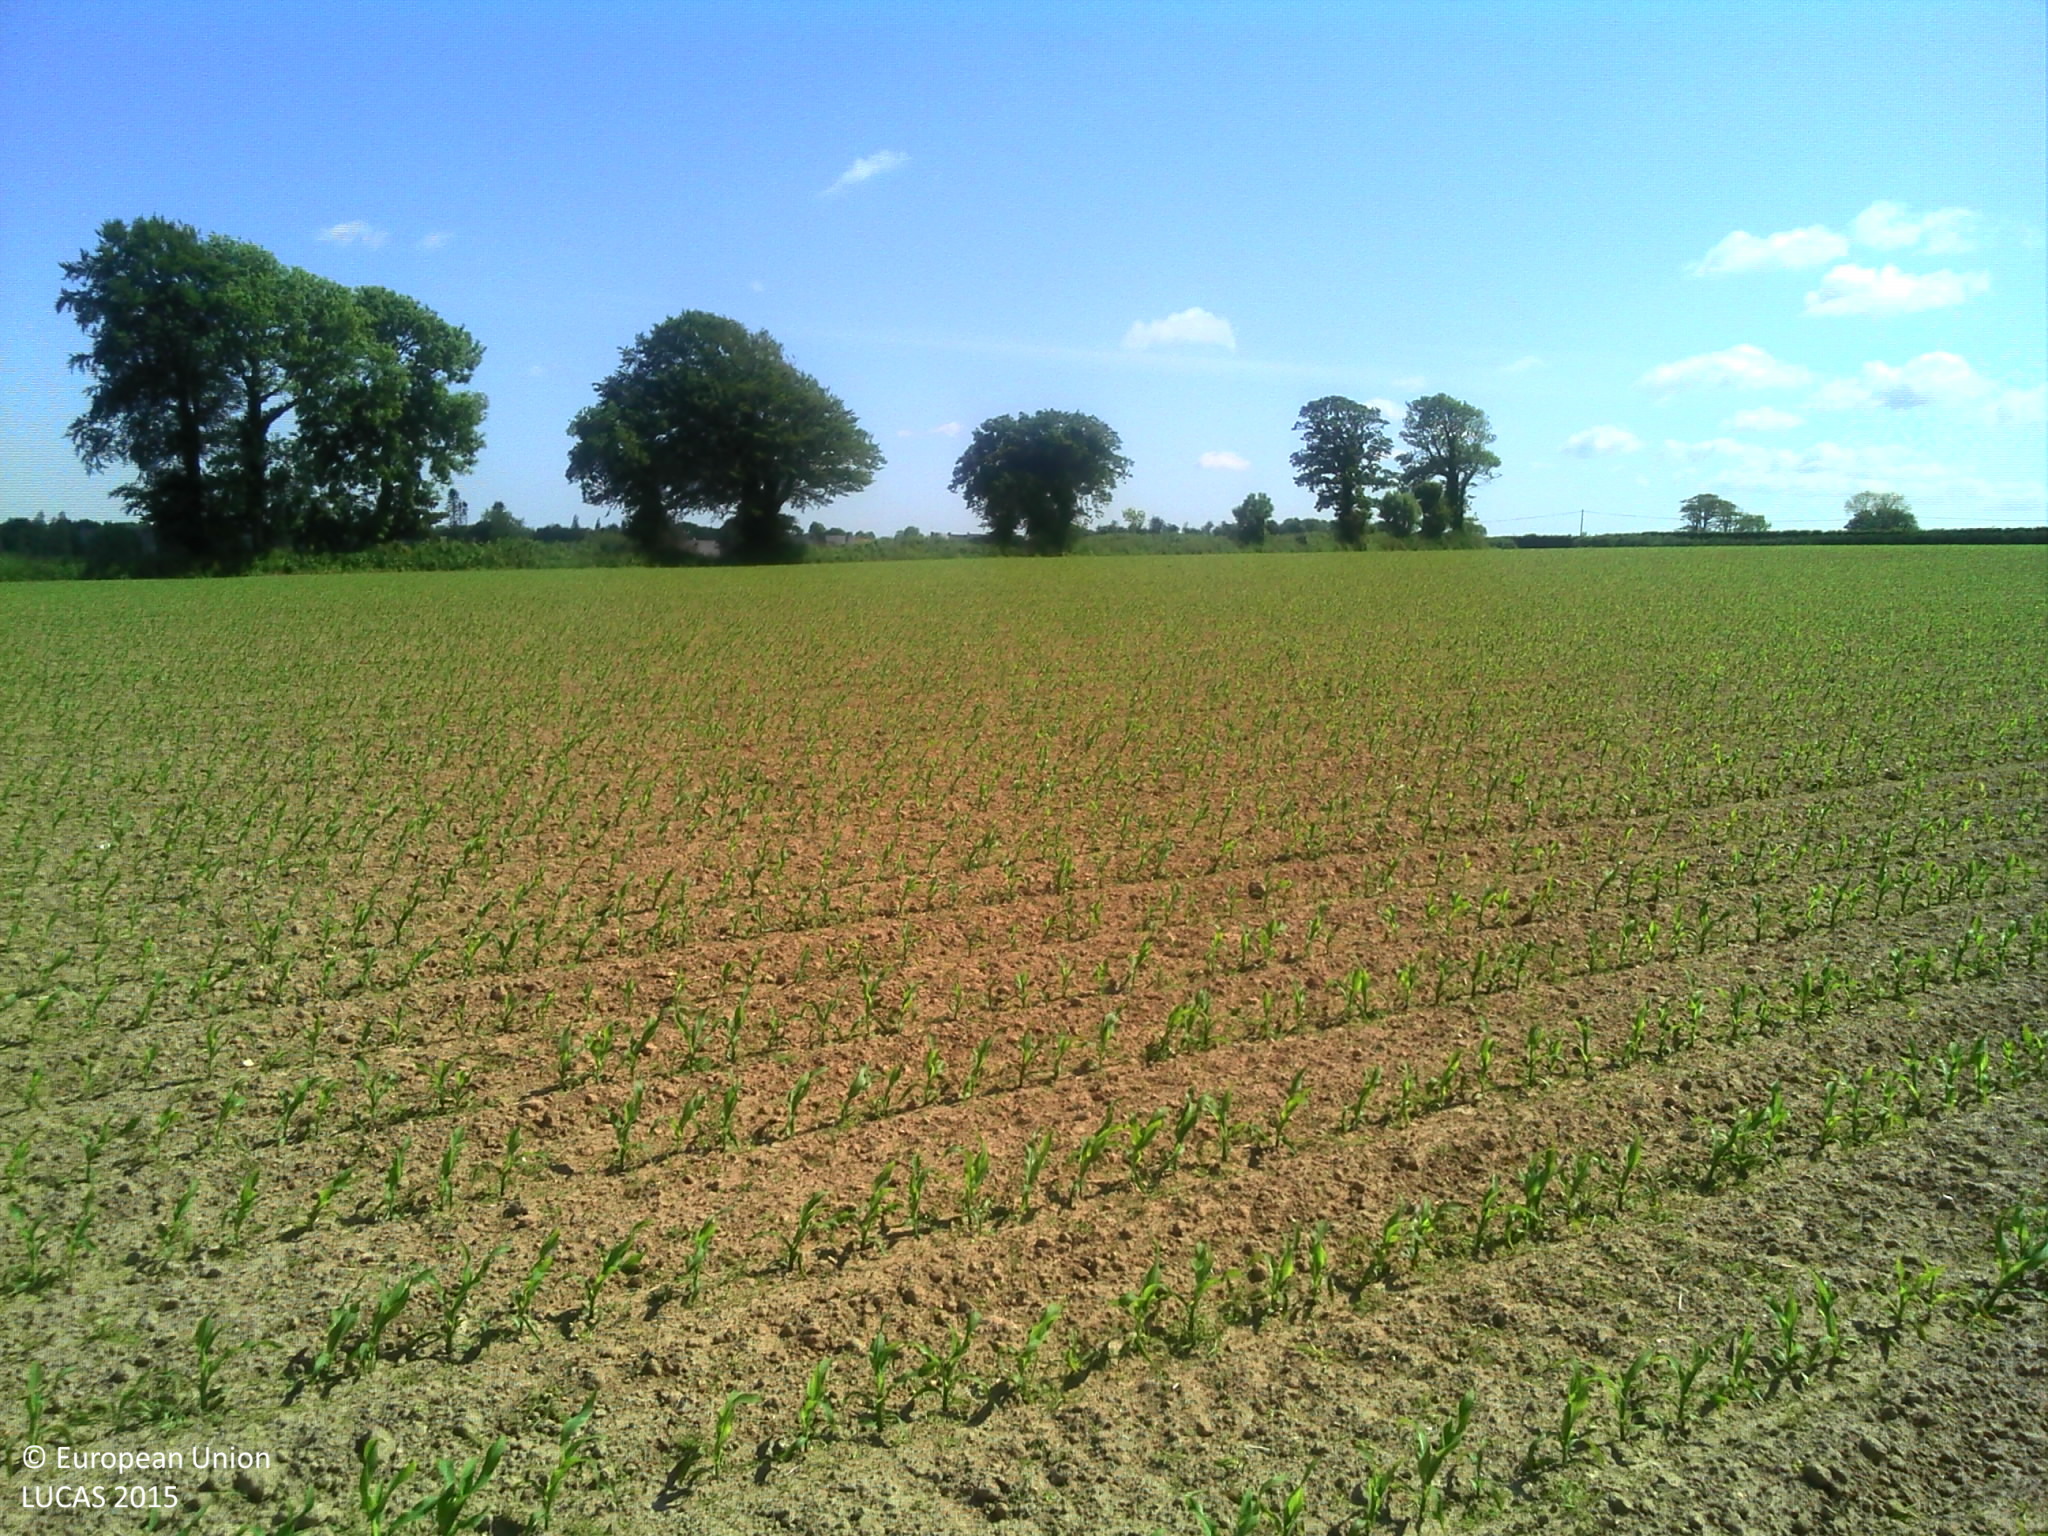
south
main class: Cropland
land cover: Maize
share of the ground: 10 - 25 %
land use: Agriculture (excluding fallow land and kitchen gardens)
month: June
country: FR
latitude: 49.6597
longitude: -1.4502
